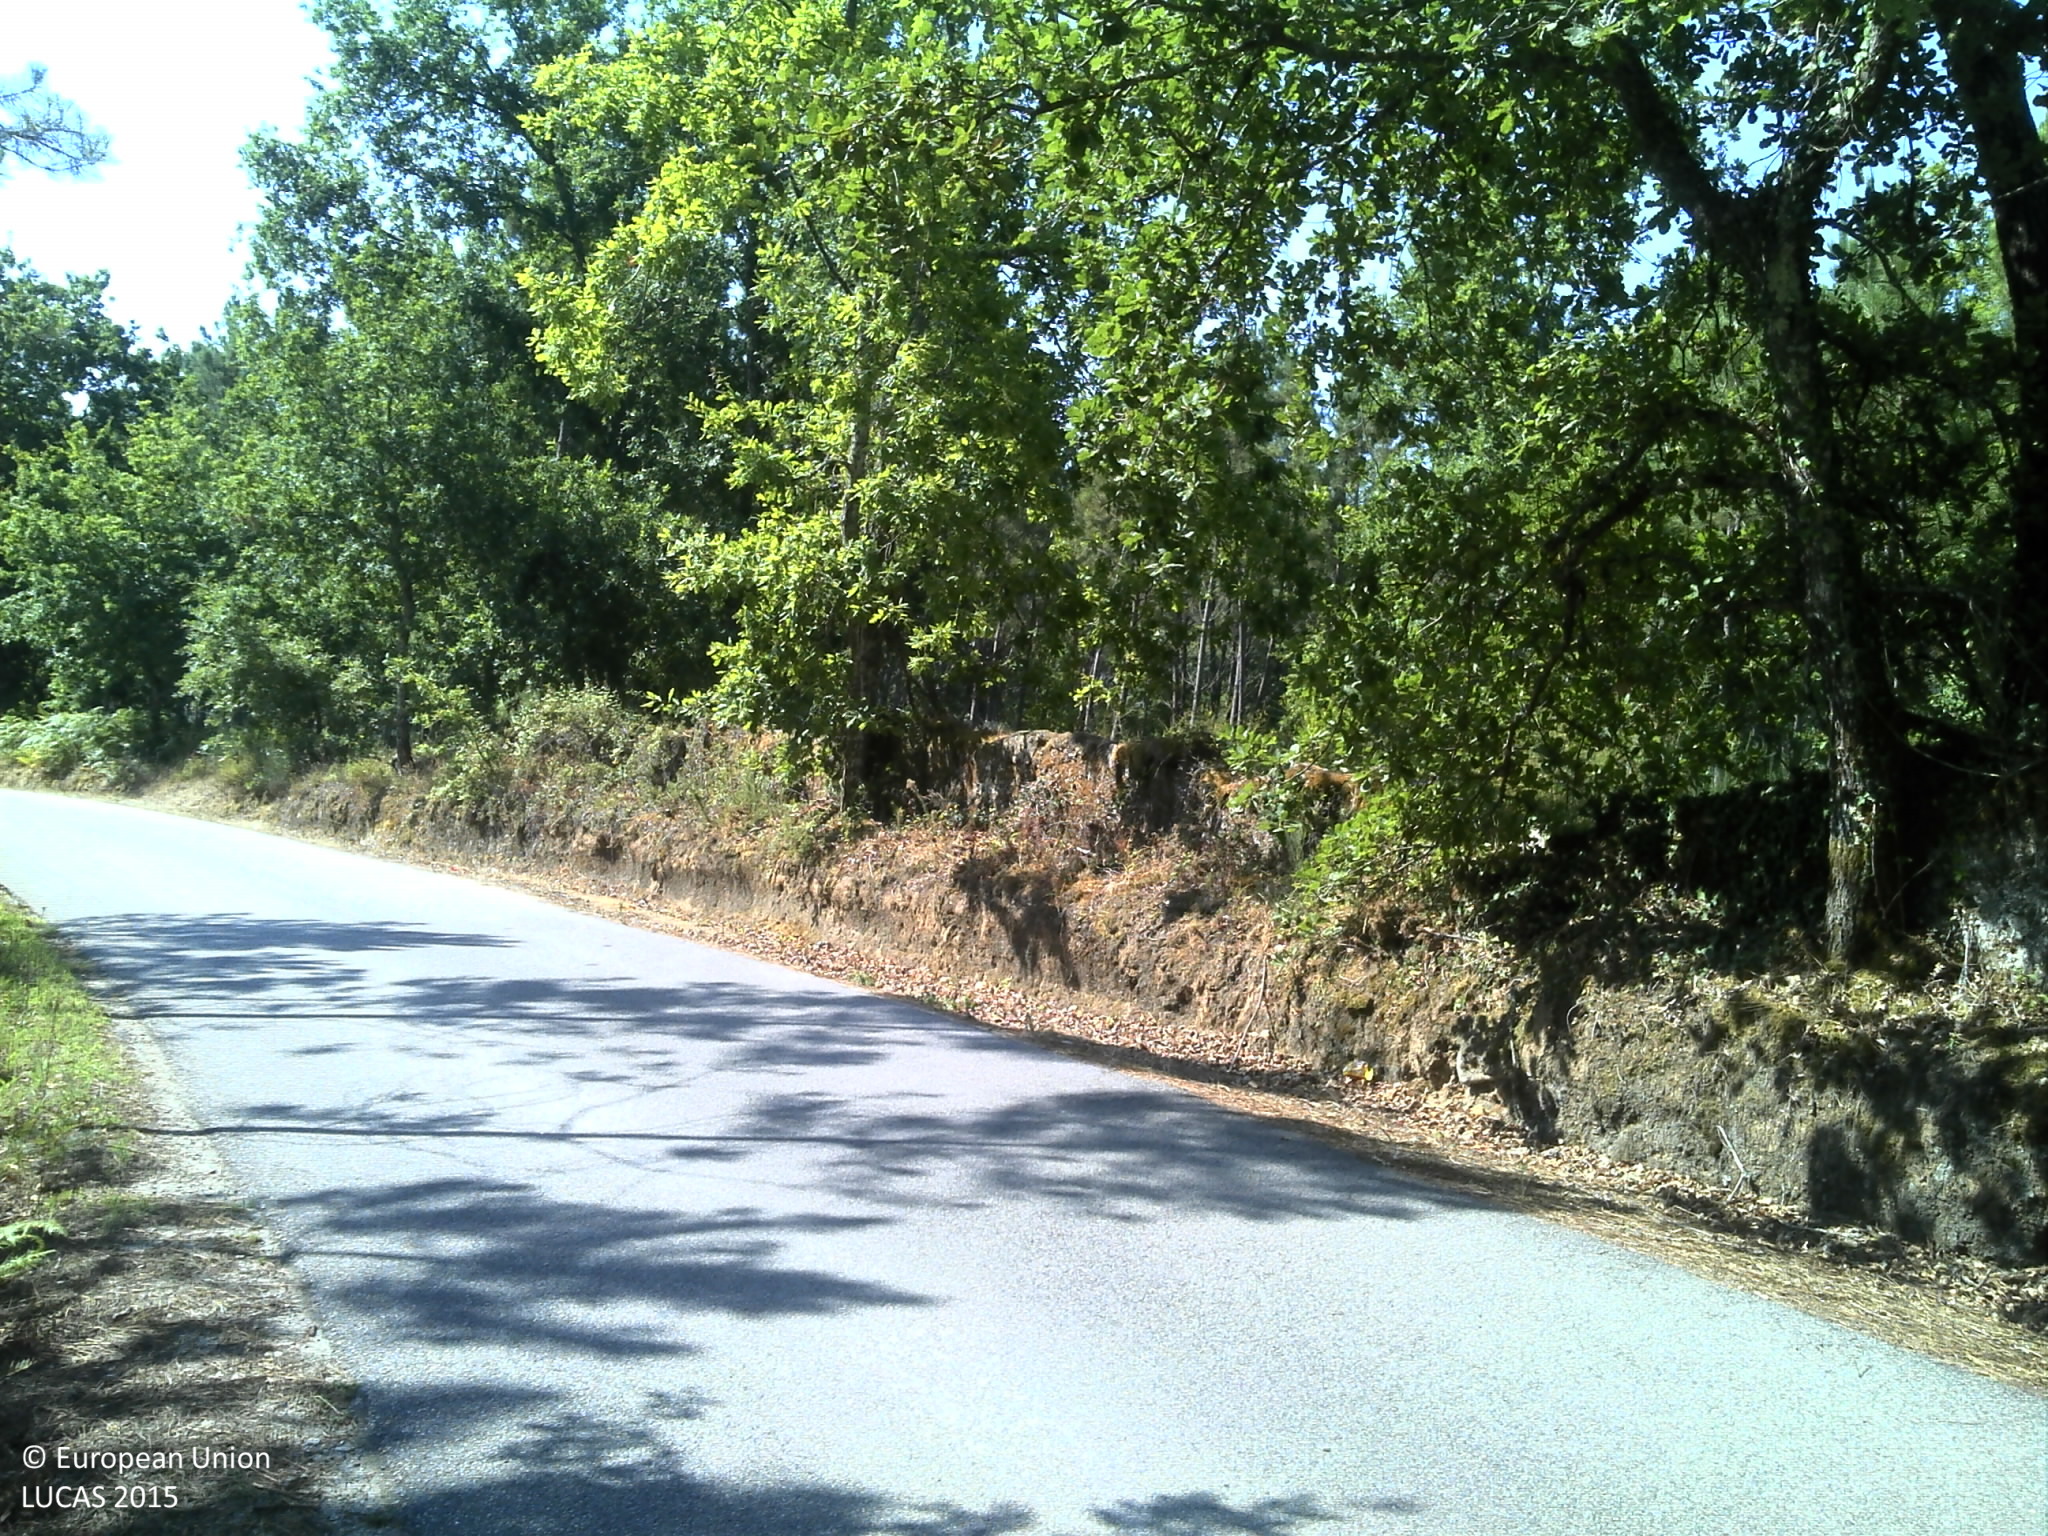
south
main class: Woodland
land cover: Pine dominated coniferous woodland
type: coniferous forest of the mediterranean region
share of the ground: 50 - 75 %
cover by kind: coniferous forest trees 60 %, shrubs 15 %, consolidated bare surface 10 %, unconsolidated bare surface 10 %, herbaceous plants 5 %
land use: Forestry
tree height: > 5 m
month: July
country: PT
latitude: 40.4294
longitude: -8.0286
